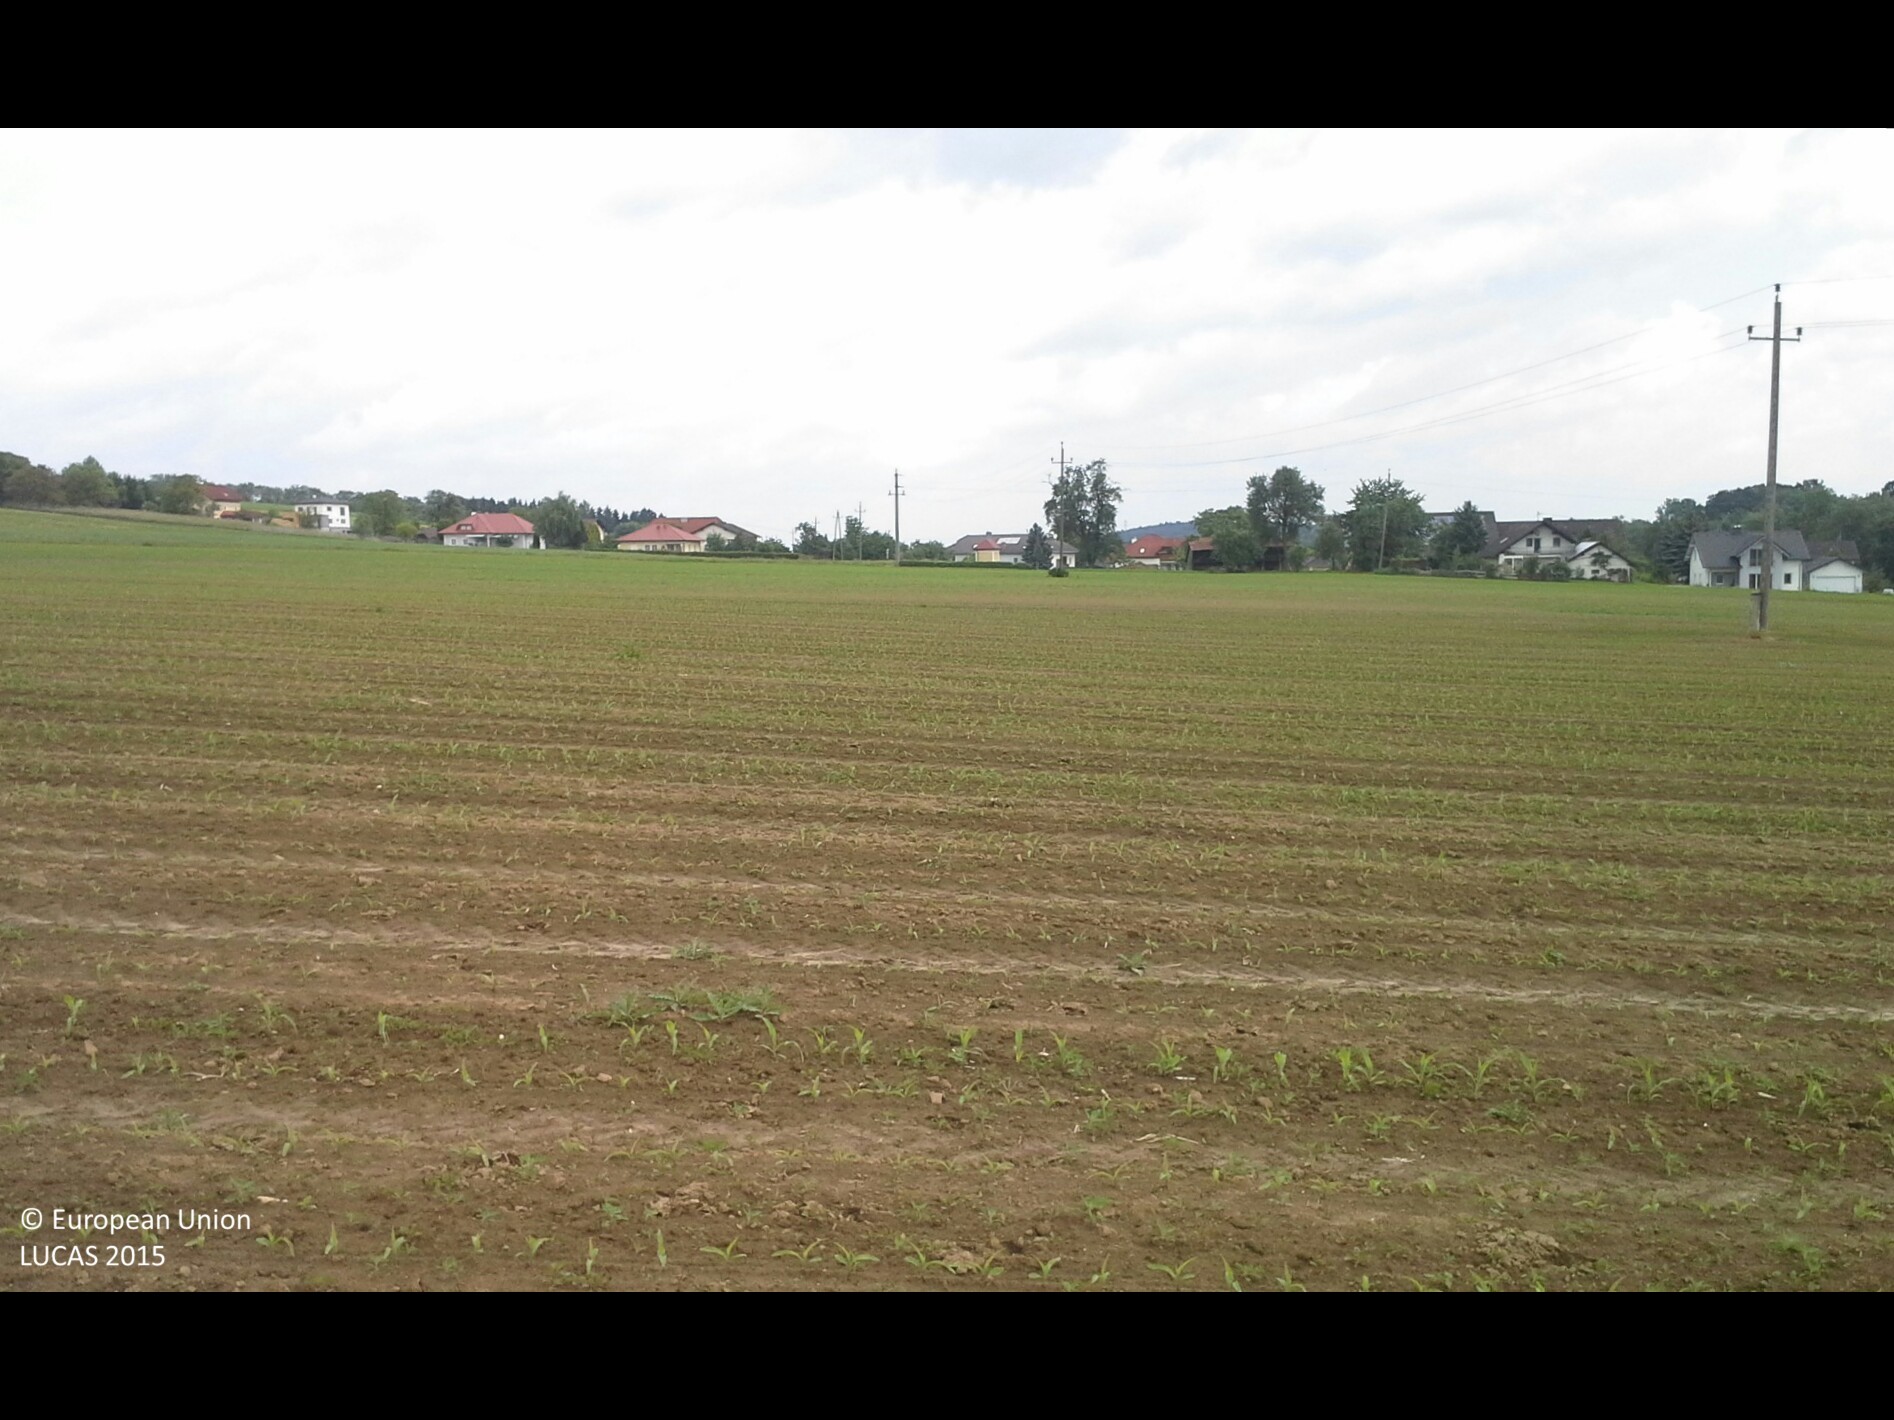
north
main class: Cropland
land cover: Maize
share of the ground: < 10 %
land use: Agriculture (excluding fallow land and kitchen gardens)
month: May
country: AT
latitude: 48.1529
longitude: 14.4226
